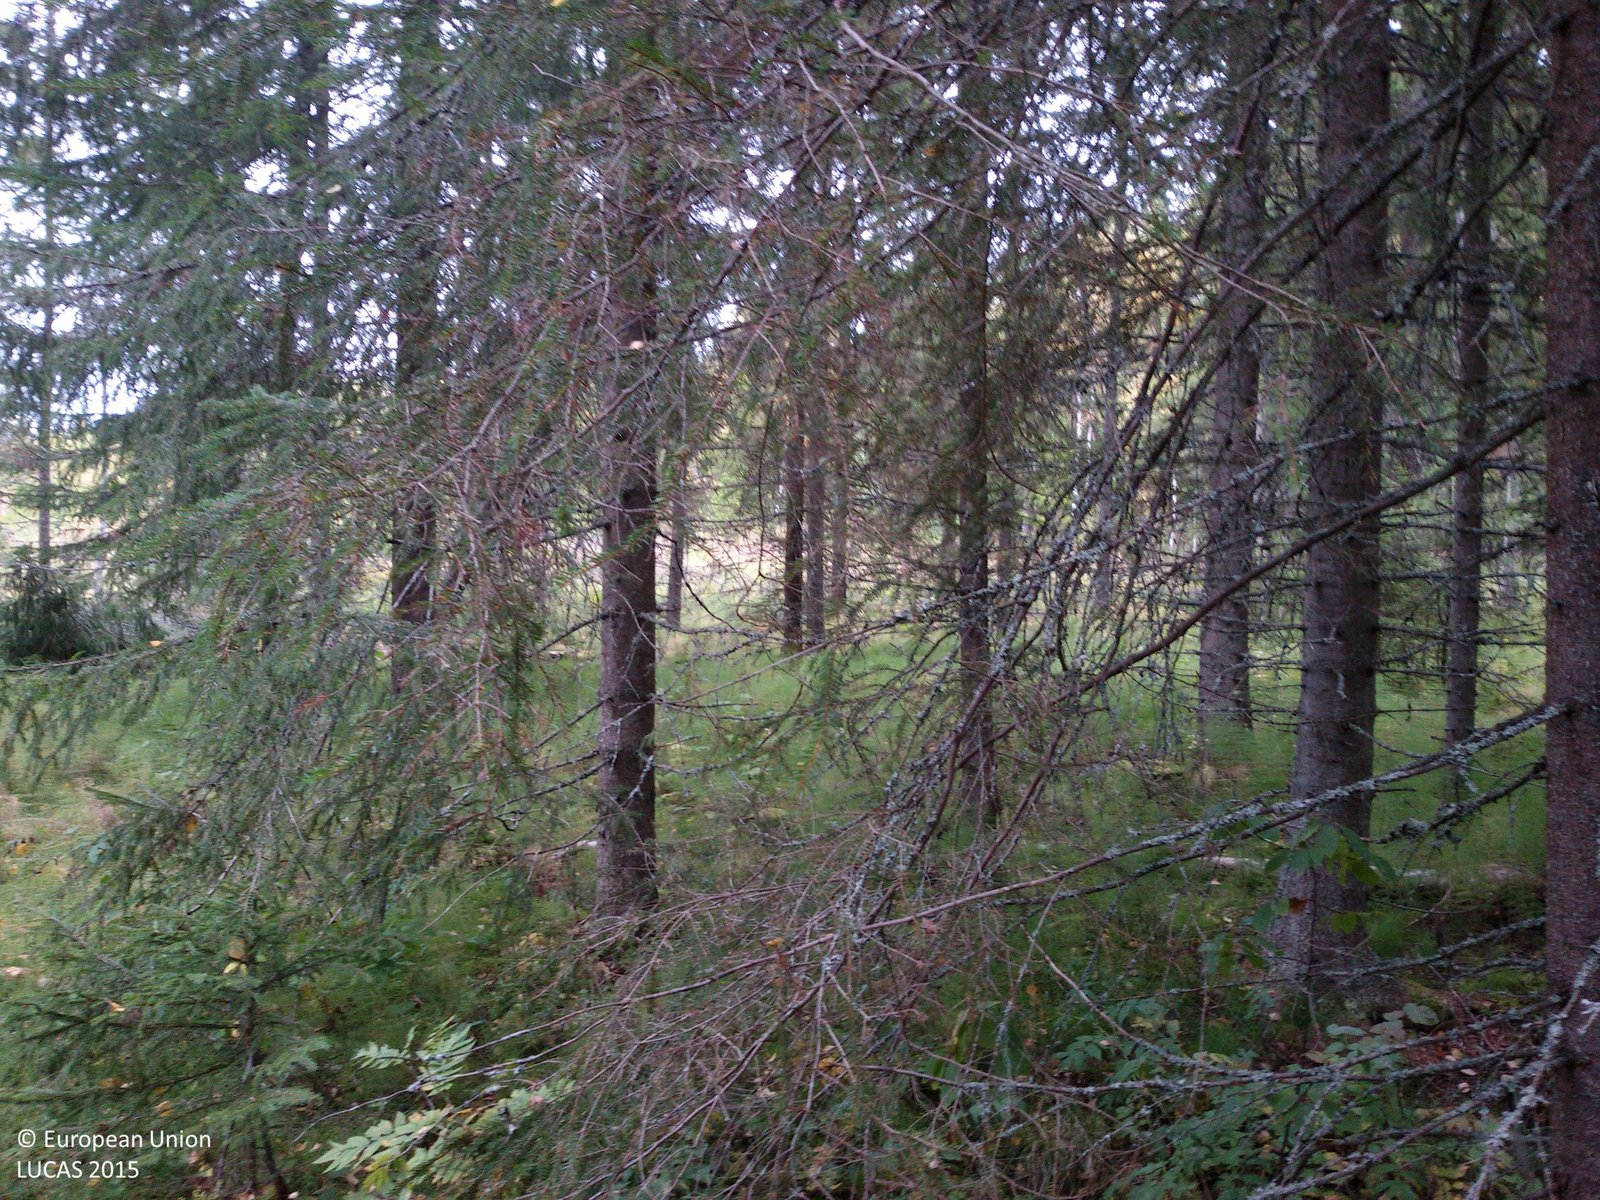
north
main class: Woodland
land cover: Spruce dominated mixed woodland
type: boreal forest
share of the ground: 50 - 75 %
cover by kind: coniferous forest trees 40 %, broadleaved forest trees 30 %, herbaceous plants 15 %, lichens and mosses 10 %, shrubs 5 %
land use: Forestry
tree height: > 5 m
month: September
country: SE
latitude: 60.7660
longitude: 14.8147
